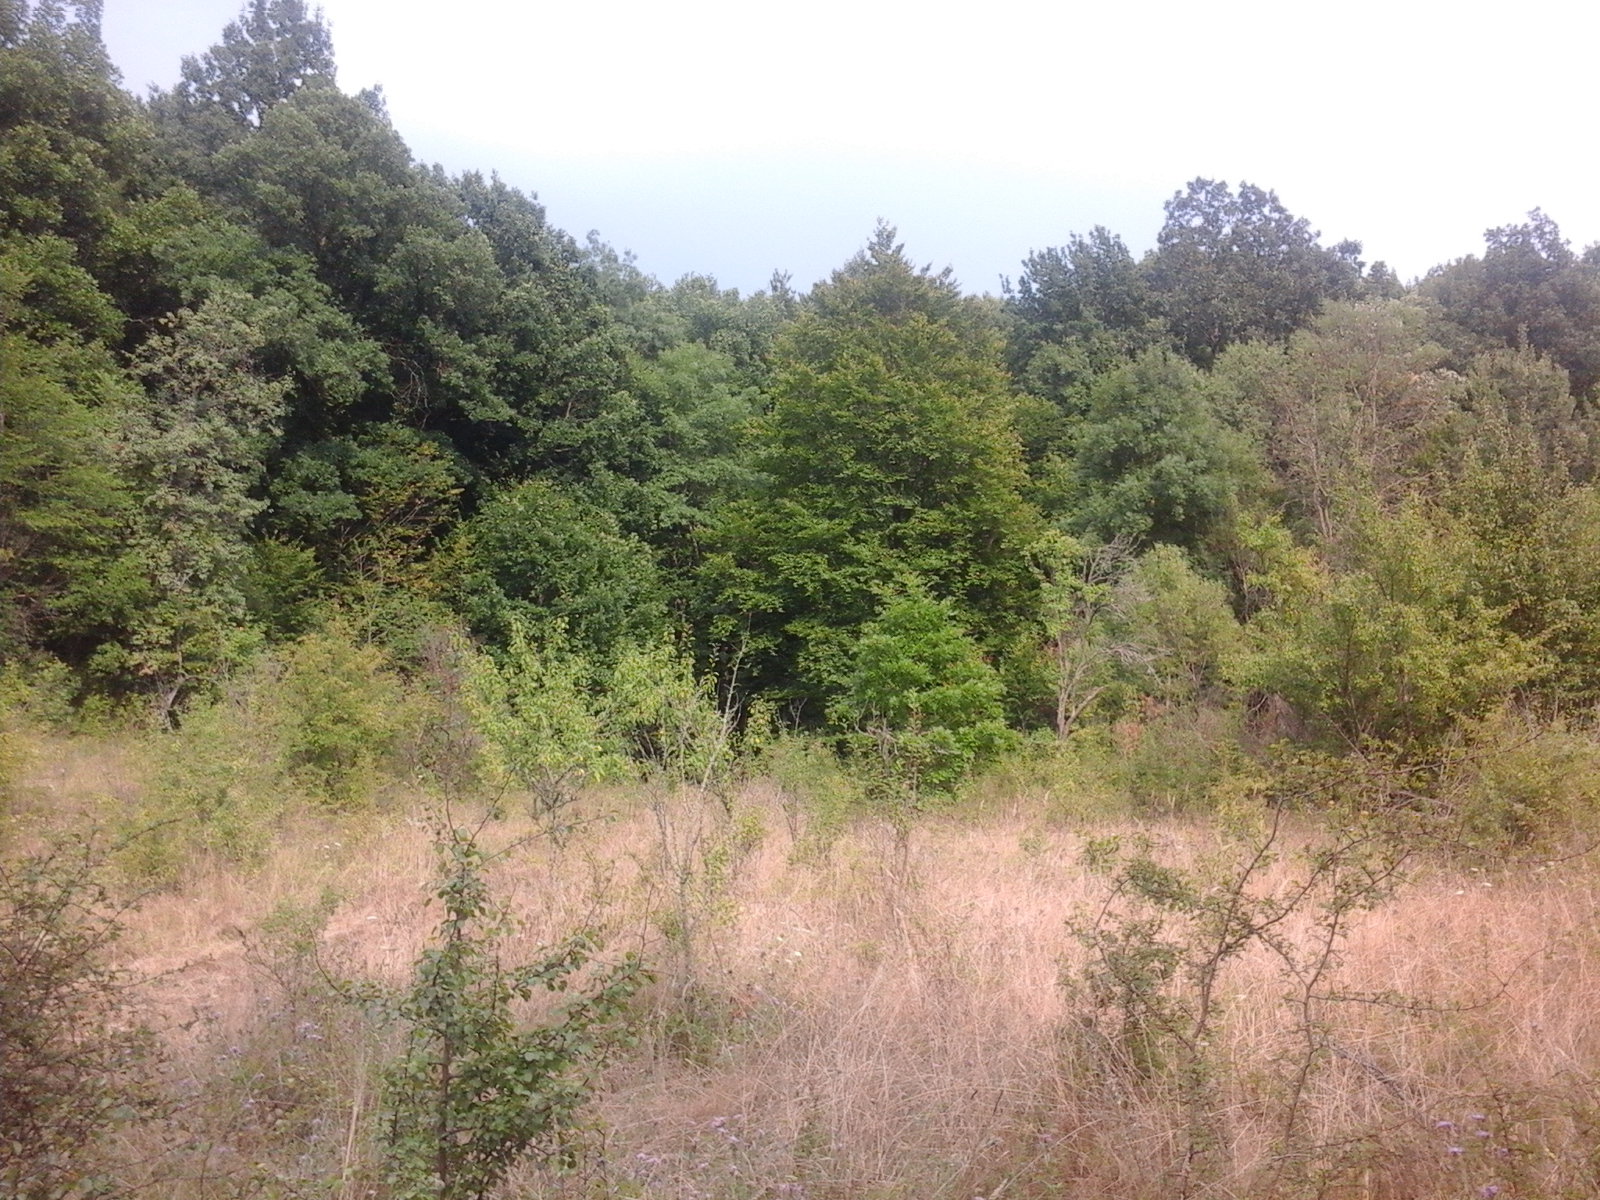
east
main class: Grassland
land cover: Grassland with sparse tree/shrub cover
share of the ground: > 75 %
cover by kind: herbaceous plants 95 %, broadleaved forest trees 5 %
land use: Agriculture (excluding fallow land and kitchen gardens)
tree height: < 5 m
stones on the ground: < 10 %
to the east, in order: Grassland with sparse tree/shrub cover; Broadleaved woodland
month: August
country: RO
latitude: 44.8247
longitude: 23.7059
